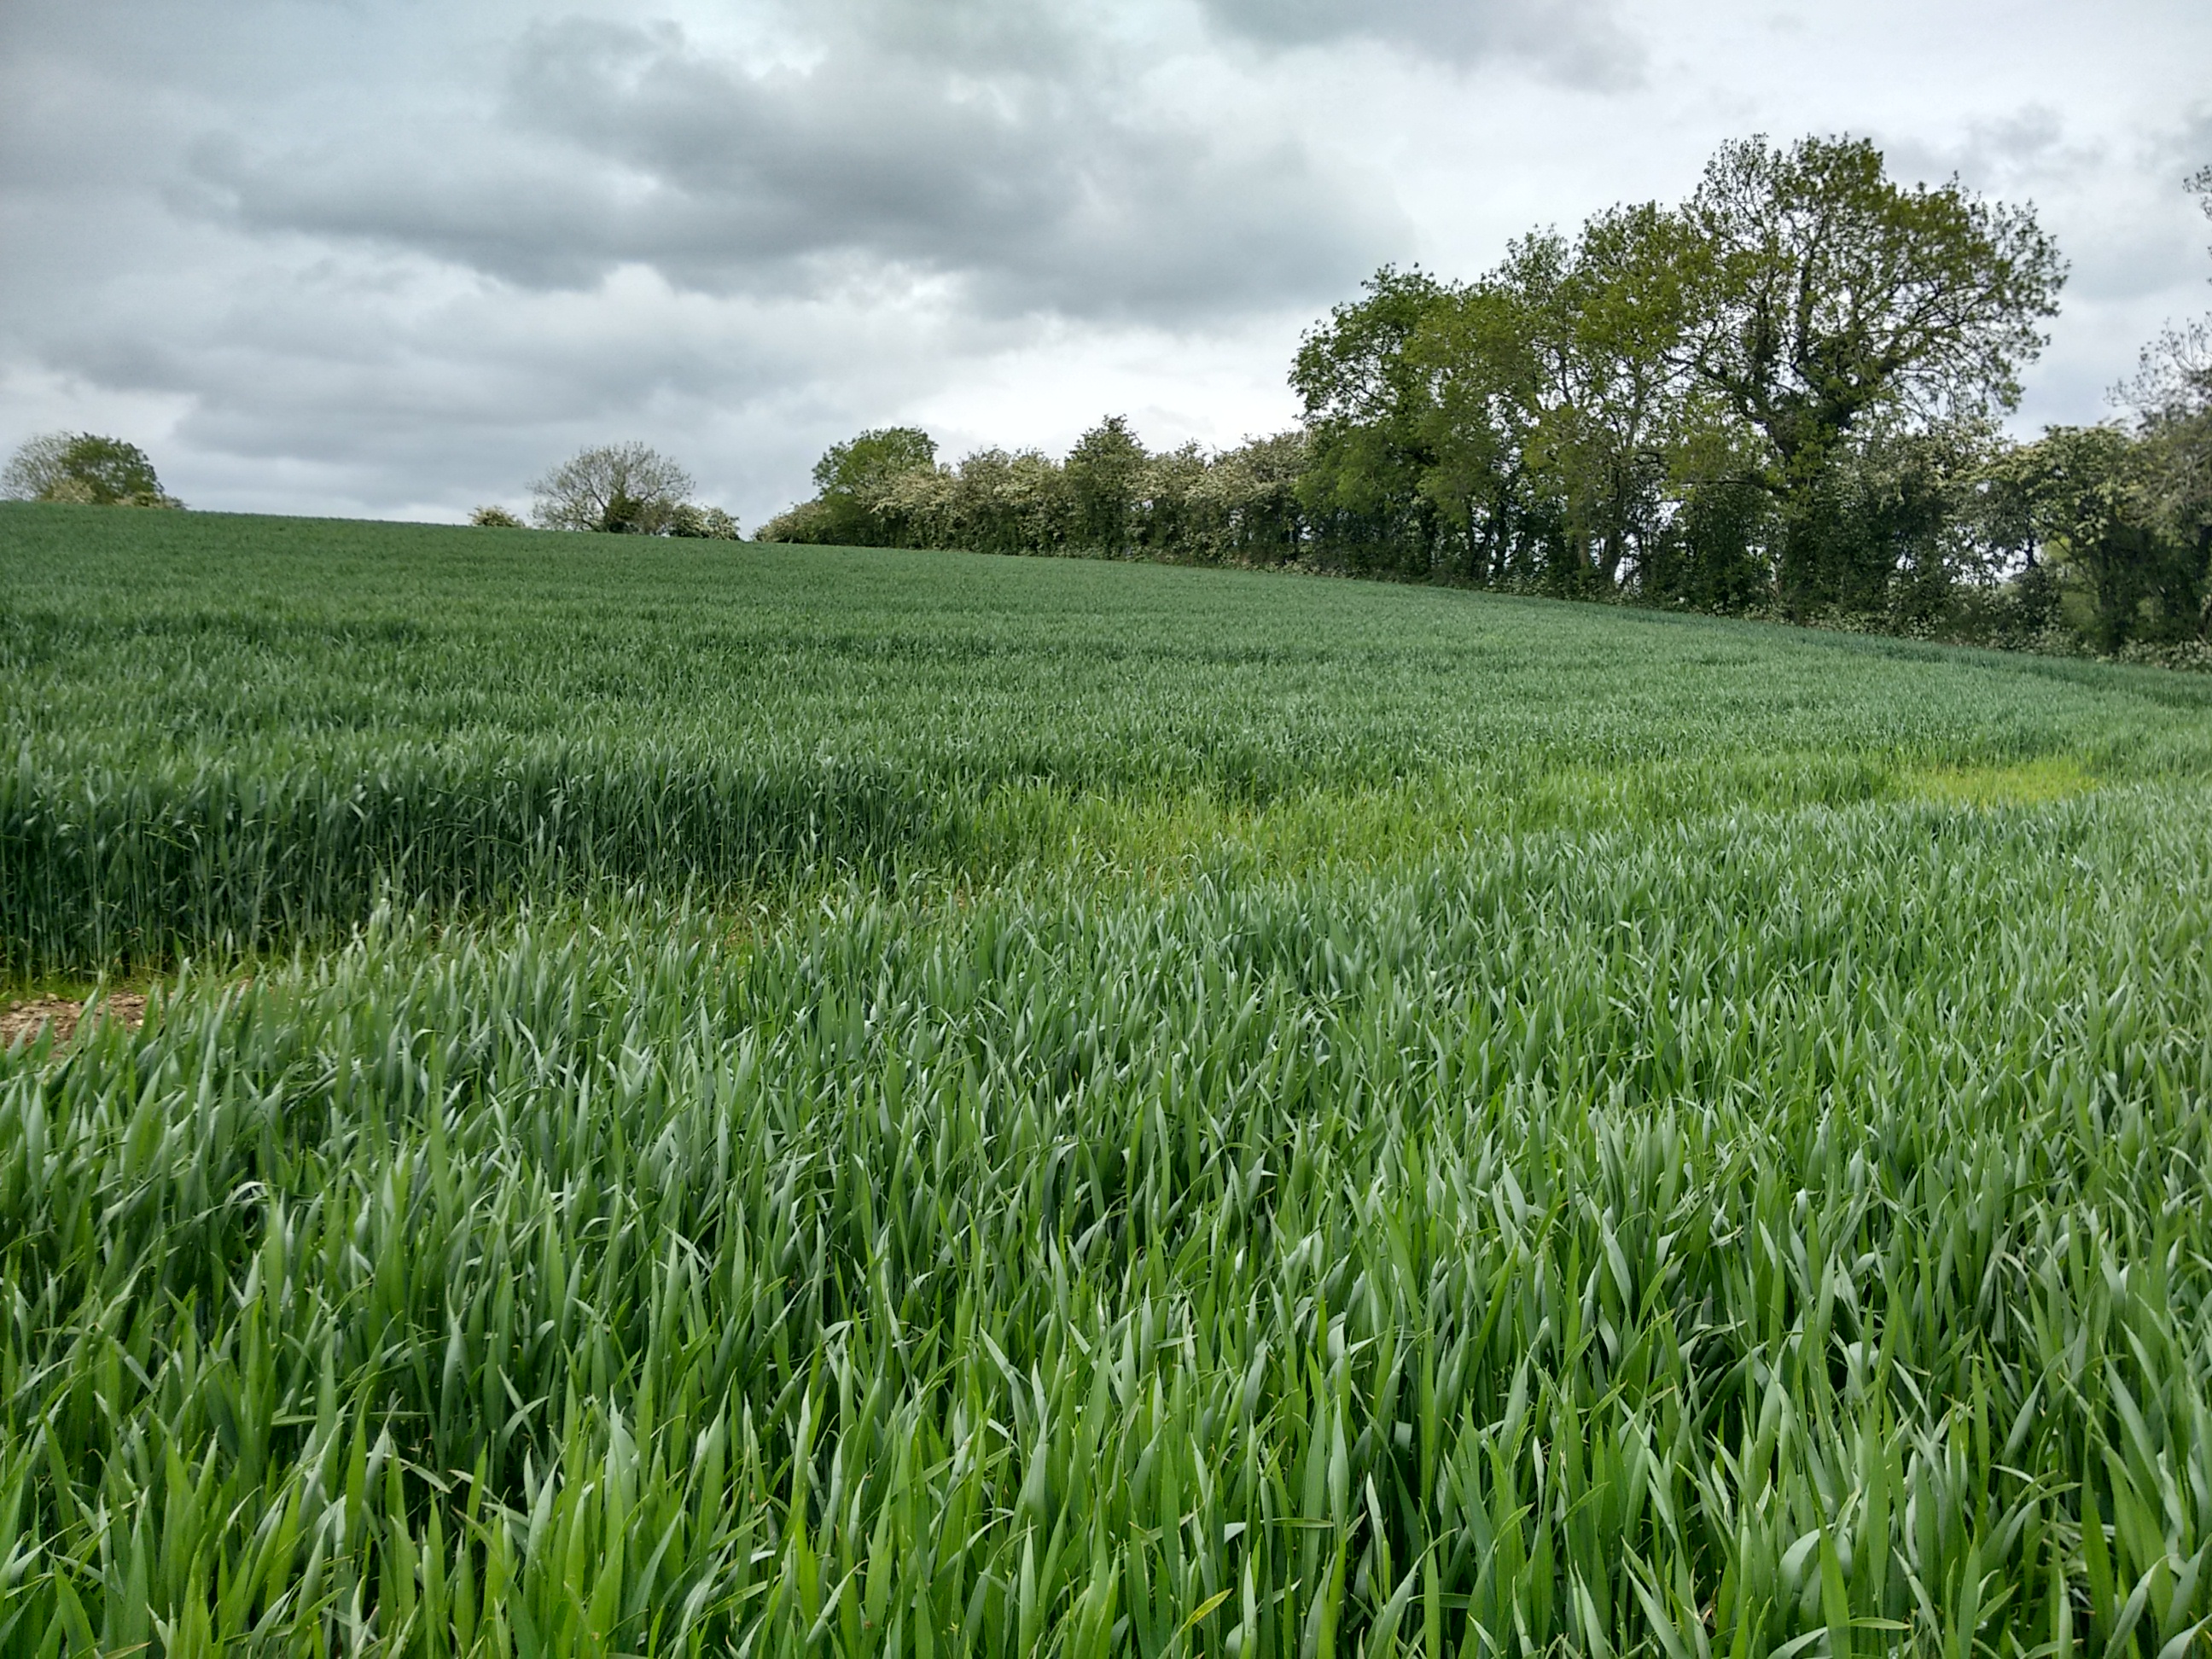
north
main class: Cropland
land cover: Barley
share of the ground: > 75 %
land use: Agriculture (excluding fallow land and kitchen gardens)
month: June
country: GB
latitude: 54.8042
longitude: -7.5011
